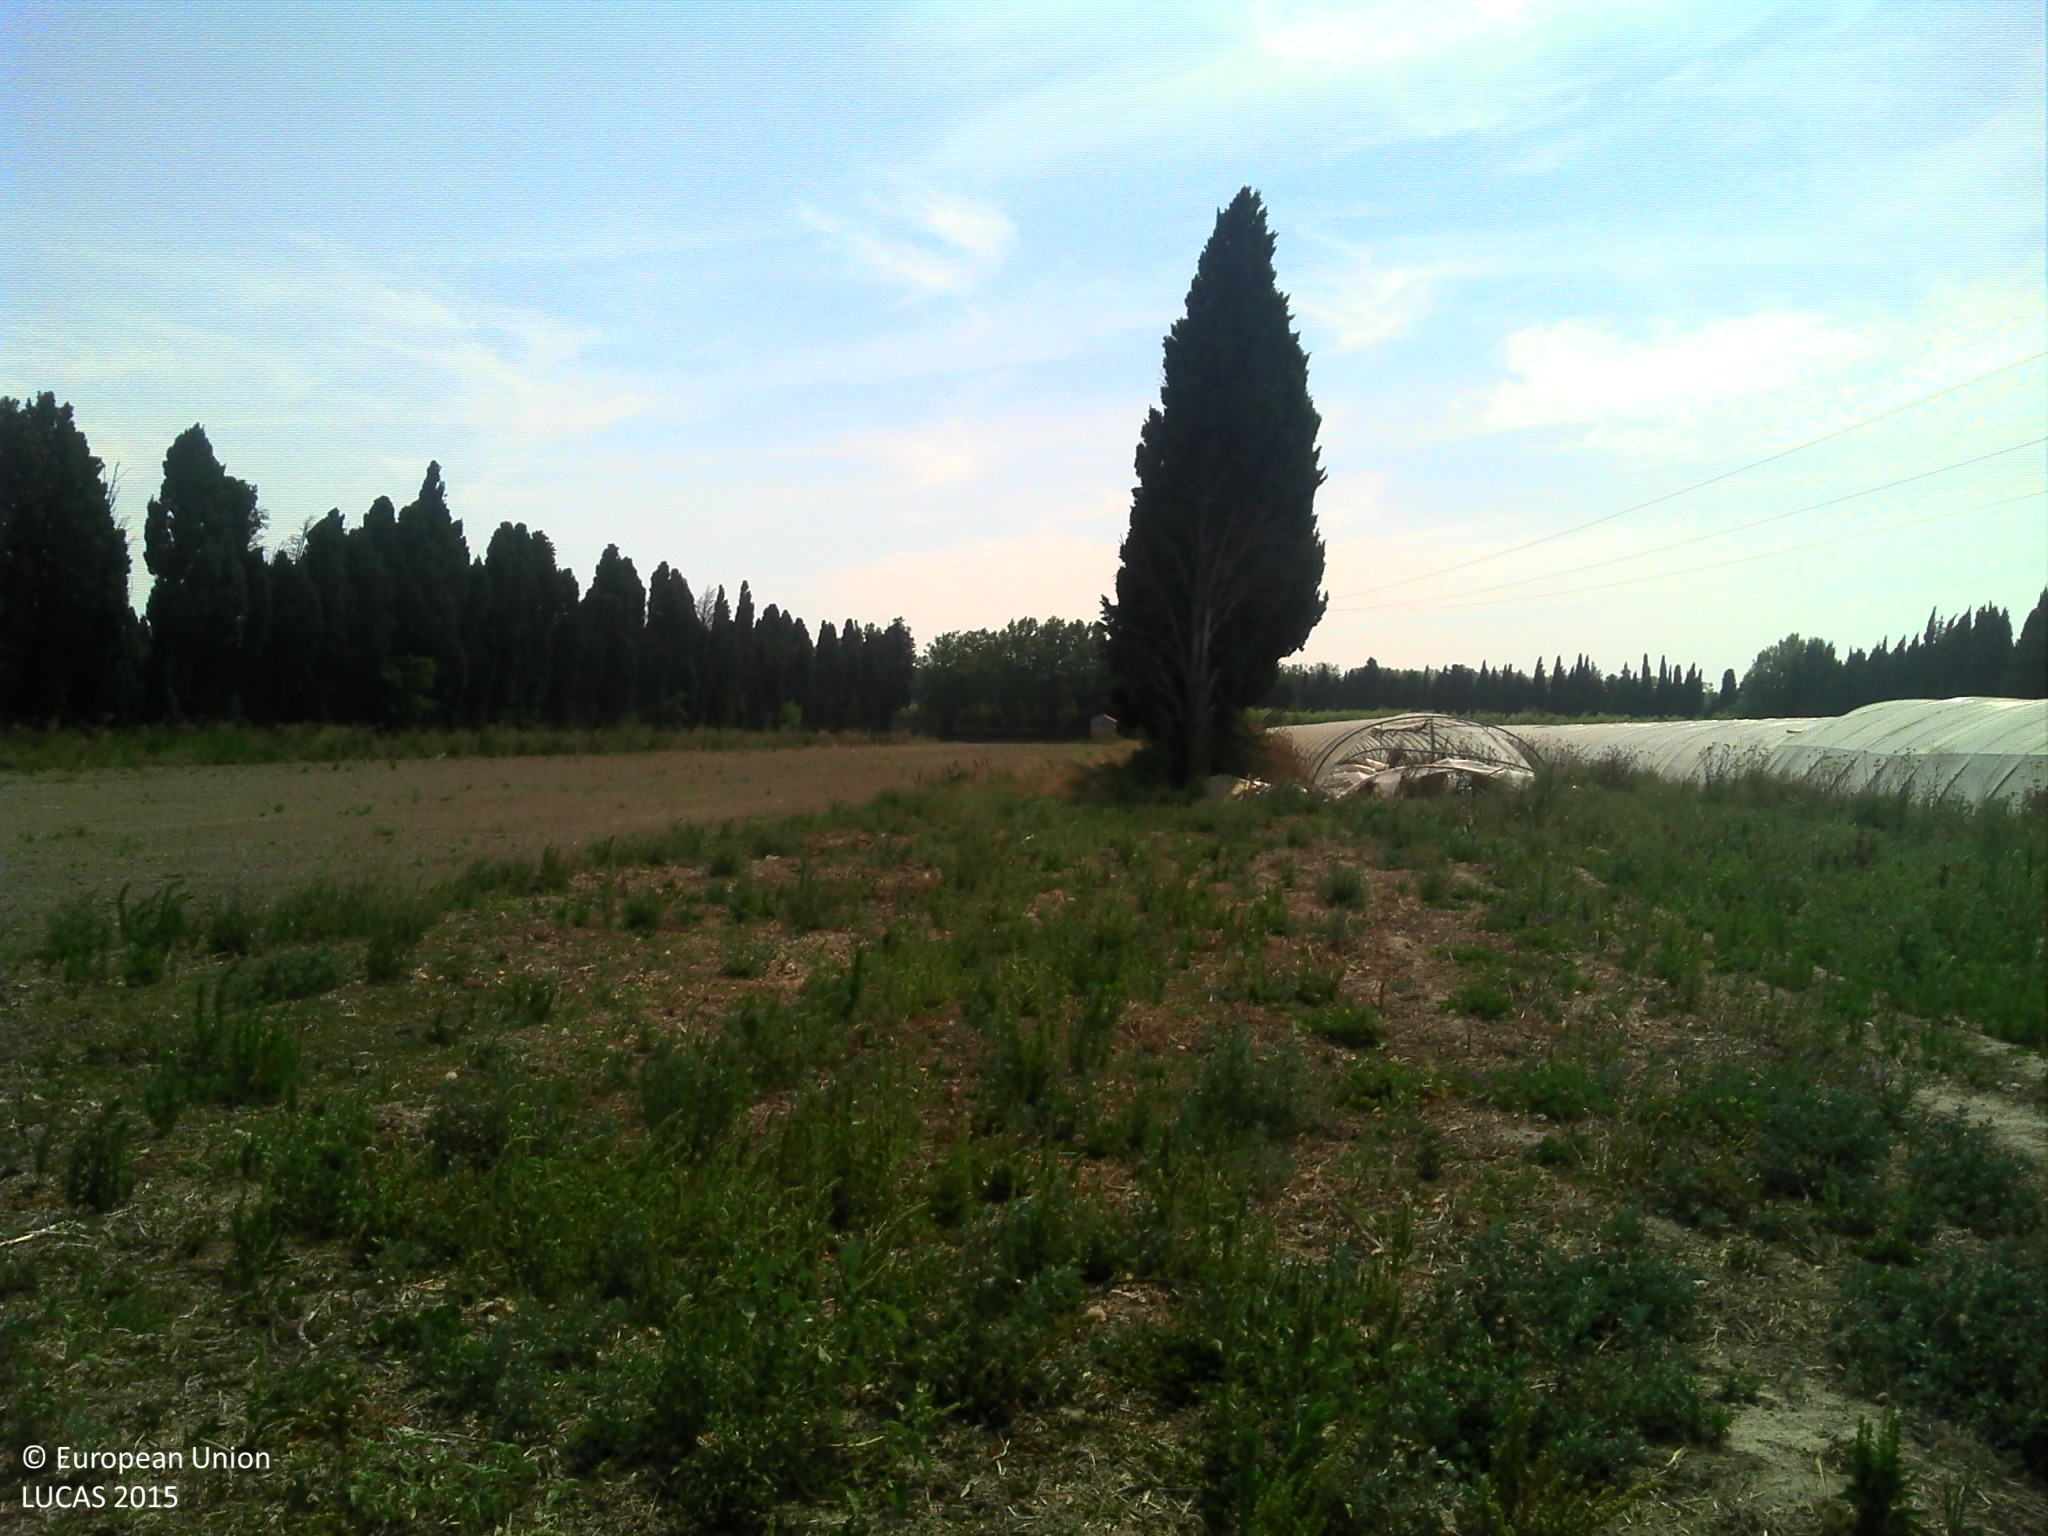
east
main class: Grassland
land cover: Spontaneously vegetated surfaces
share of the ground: 50 - 75 %
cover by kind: herbaceous plants 50 %, unconsolidated bare surface 50 %
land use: Abandoned areas
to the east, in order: Spontaneously vegetated surfaces; Other bare soil; Spontaneously vegetated surfaces
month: July
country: FR
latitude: 43.8238
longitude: 4.8239
